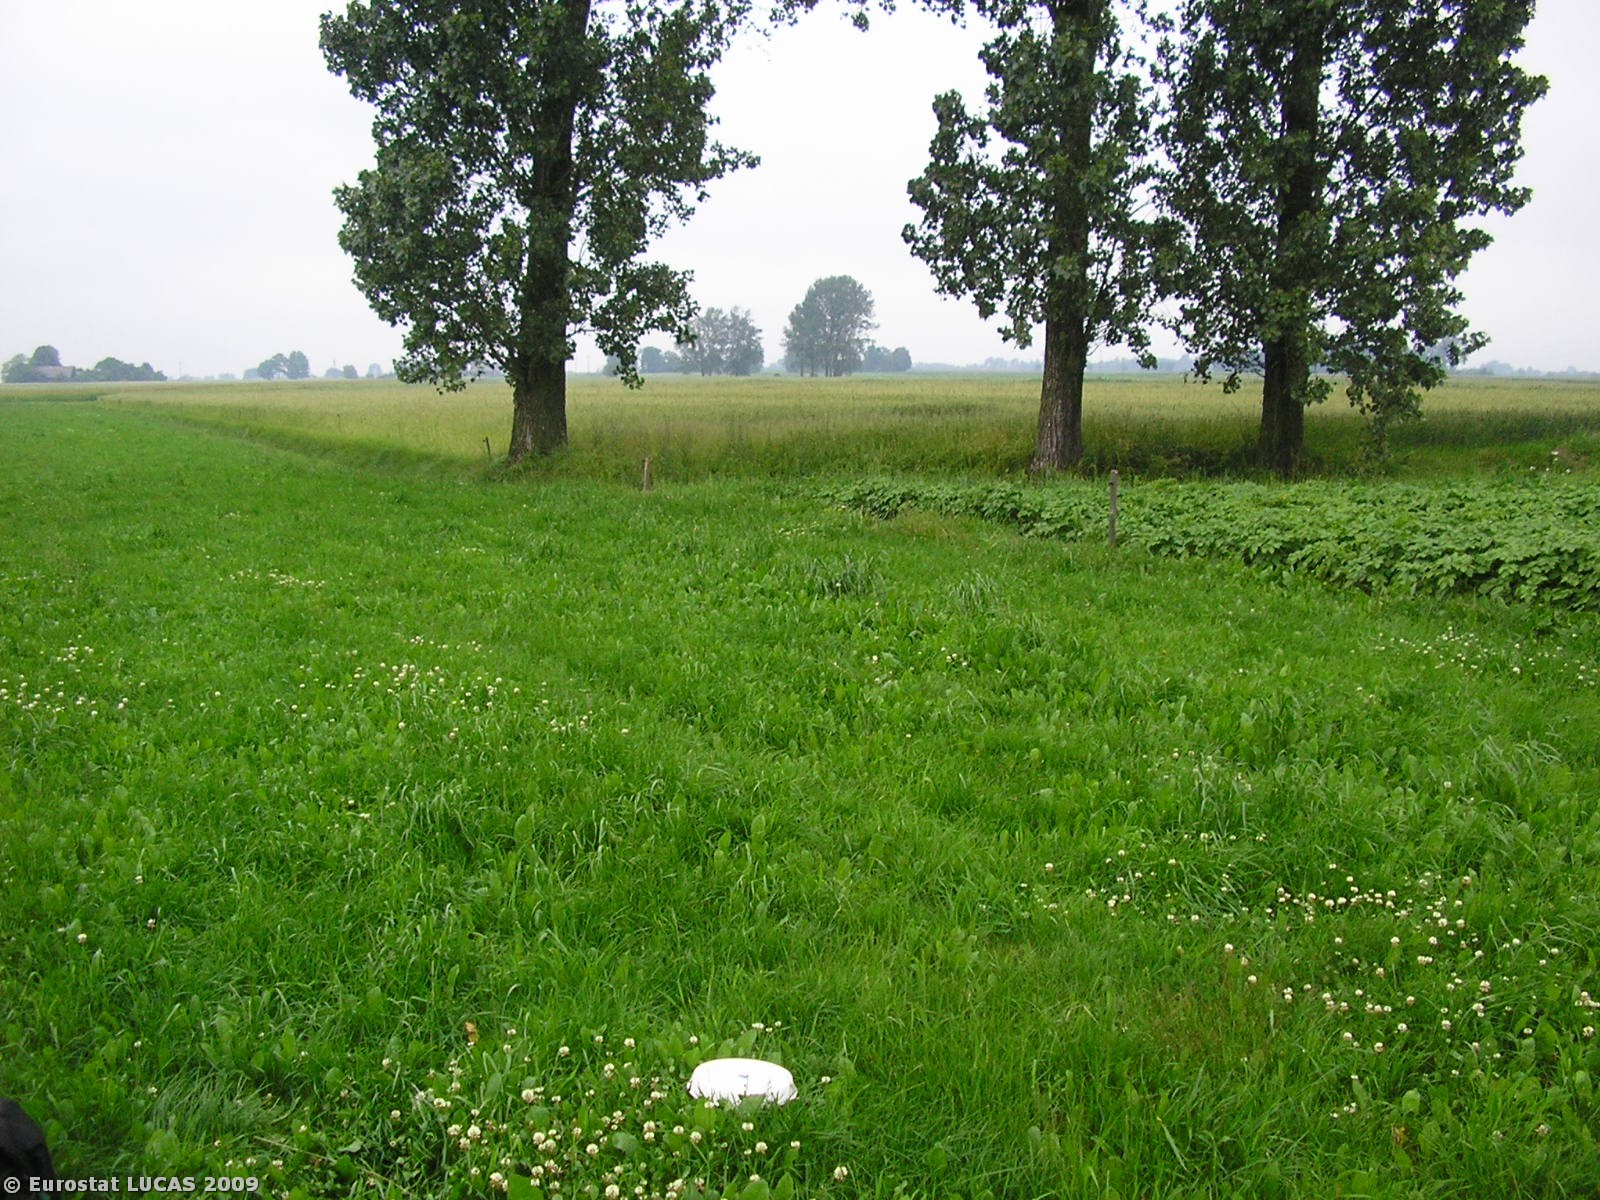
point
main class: Grassland
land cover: Grassland without tree/shrub cover
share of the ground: > 75 %
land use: Agriculture (excluding fallow land and kitchen gardens)
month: June
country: PL
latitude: 51.2458
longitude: 18.4281
